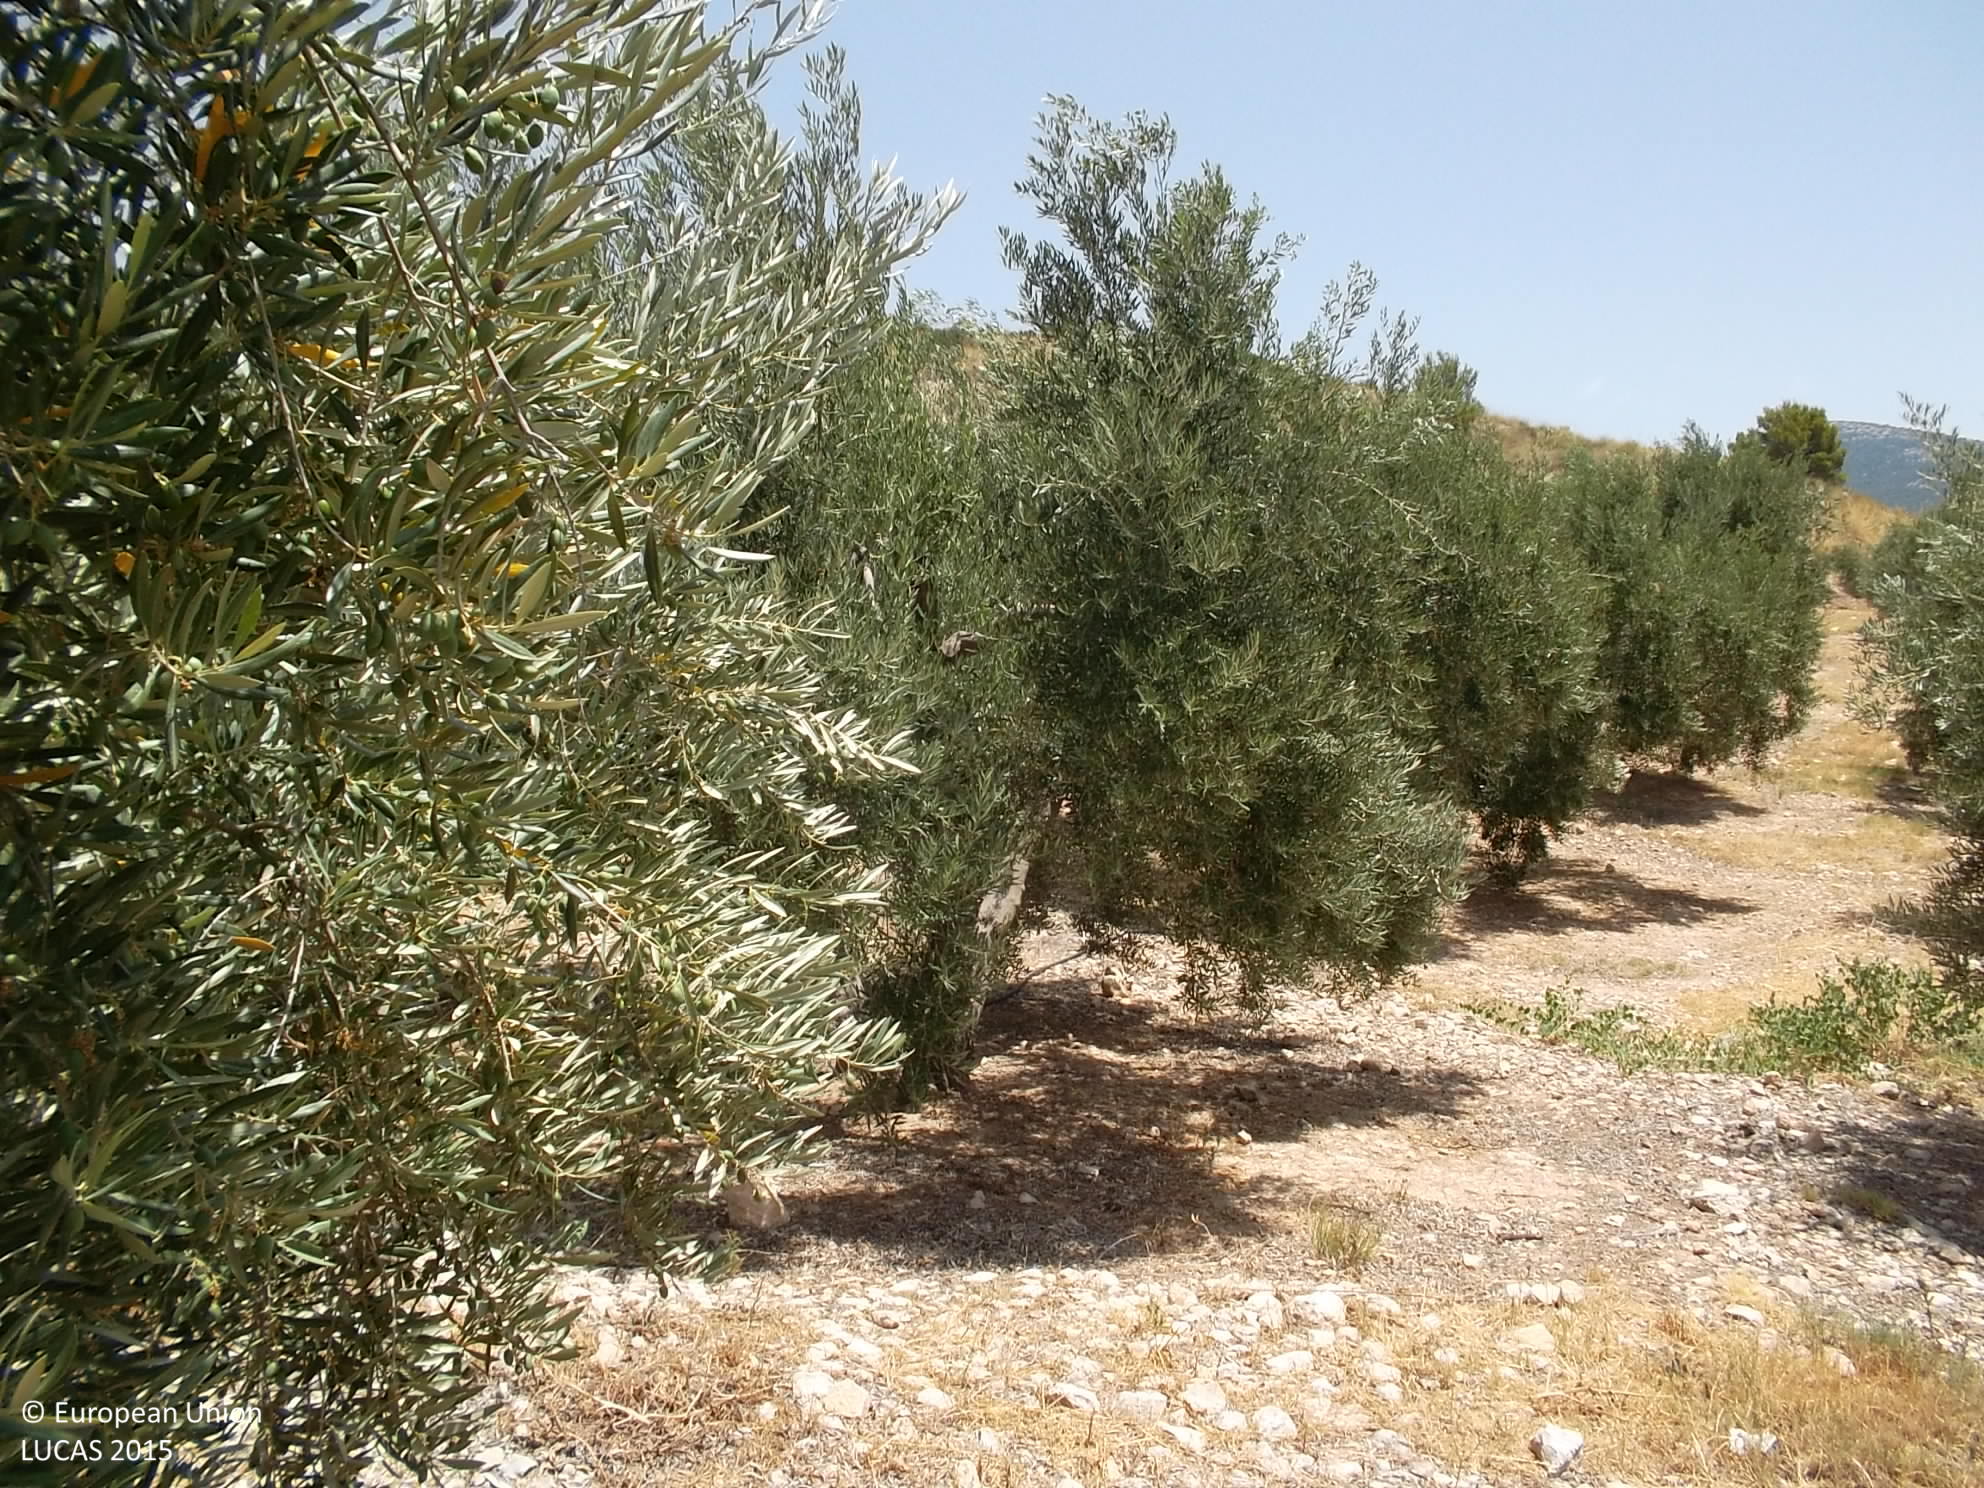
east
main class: Cropland
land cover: Olive groves
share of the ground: 25 - 50 %
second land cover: Spontaneously vegetated surfaces
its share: > 75 %
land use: Agriculture (excluding fallow land and kitchen gardens)
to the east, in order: Olive groves; Spontaneously vegetated surfaces; Shruby margins; Tracks; Grassland without tree/shrub cover; Olive groves; Grassland without tree/shrub cover; Tracks; Grassland without tree/shrub cover
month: June
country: ES
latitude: 37.7452
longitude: -3.0327
